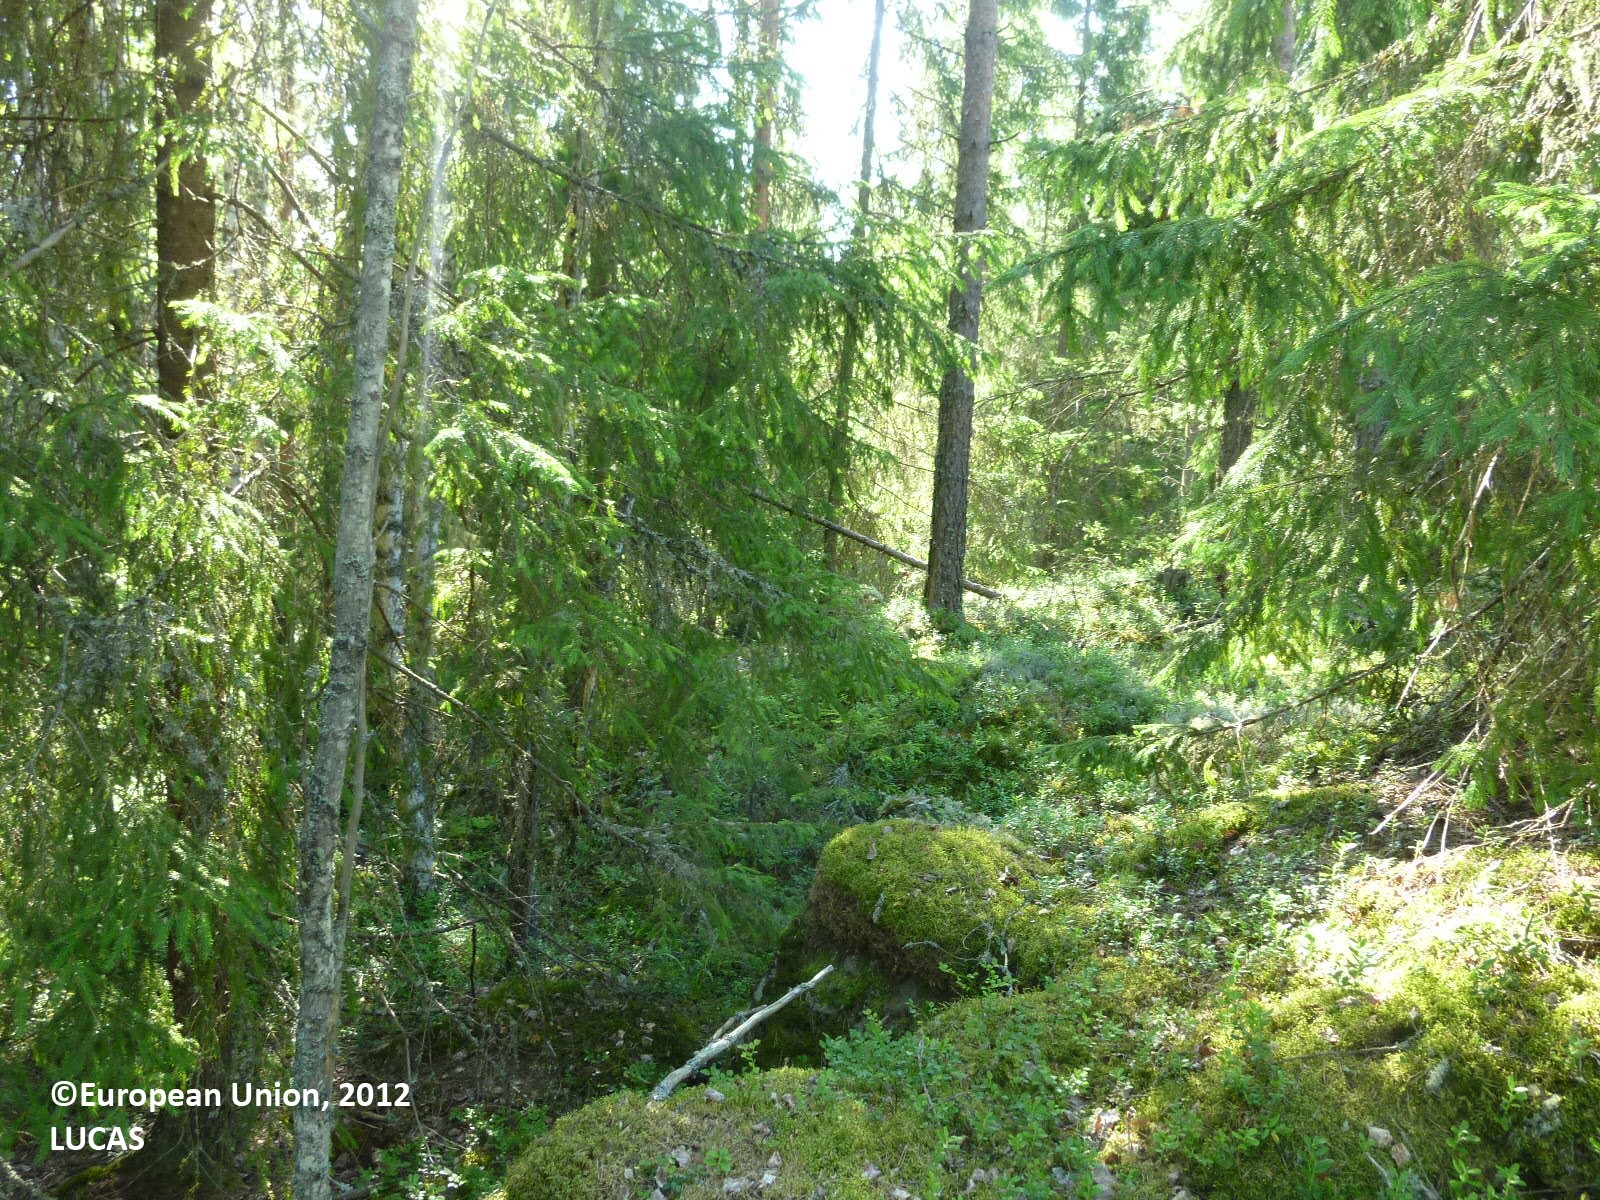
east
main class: Woodland
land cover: Pine dominated mixed woodland
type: boreal forest
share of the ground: 25 - 50 %
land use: Forestry
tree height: > 5 m
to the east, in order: Pine dominated mixed woodland; Spruce dominated mixed woodland; Tracks; Spruce dominated mixed woodland; Ditches and canals; Grass margins; Paved roads, cycling and walking lanes; Grassland with sparse tree/shrub cover; Ditches and canals; Spruce dominated mixed woodland; Tracks; Spruce dominated mixed woodland
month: July
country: FI
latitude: 61.1680
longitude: 22.5773
